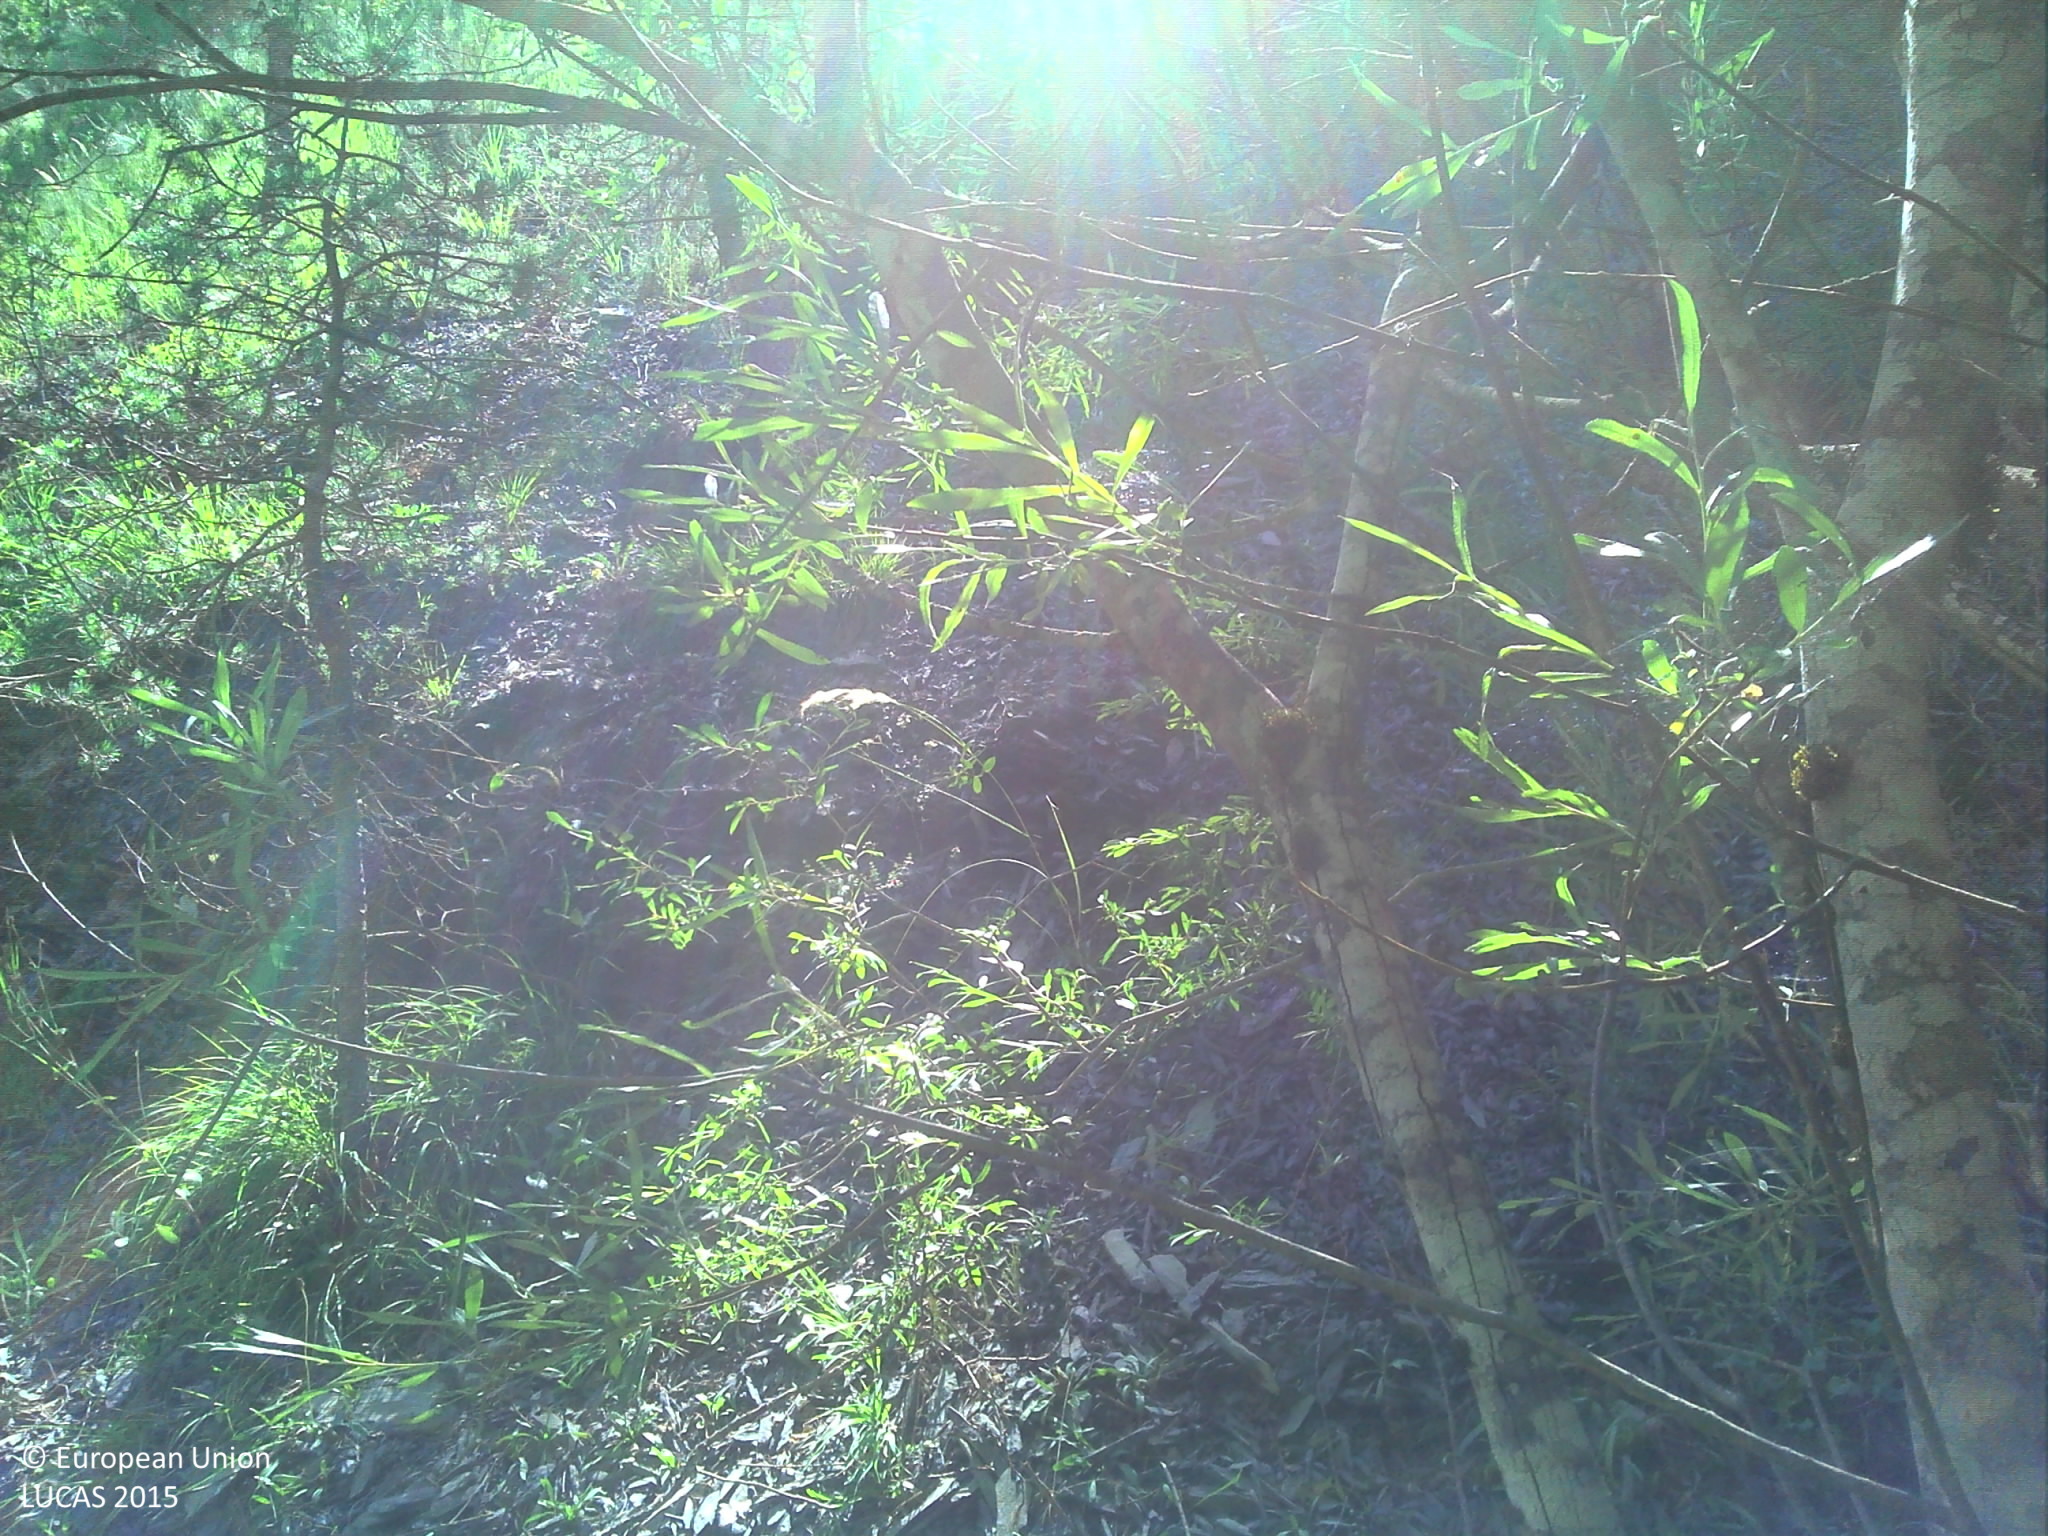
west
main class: Woodland
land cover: Pine dominated mixed woodland
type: alpine coniferous forest
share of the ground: 50 - 75 %
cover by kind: coniferous forest trees 30 %, broadleaved forest trees 20 %, shrubs 20 %, herbaceous plants 20 %, consolidated bare surface 10 %
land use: Forestry
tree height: > 5 m
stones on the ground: 10 - 25 %
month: August
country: FR
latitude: 44.3363
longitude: 6.2319
